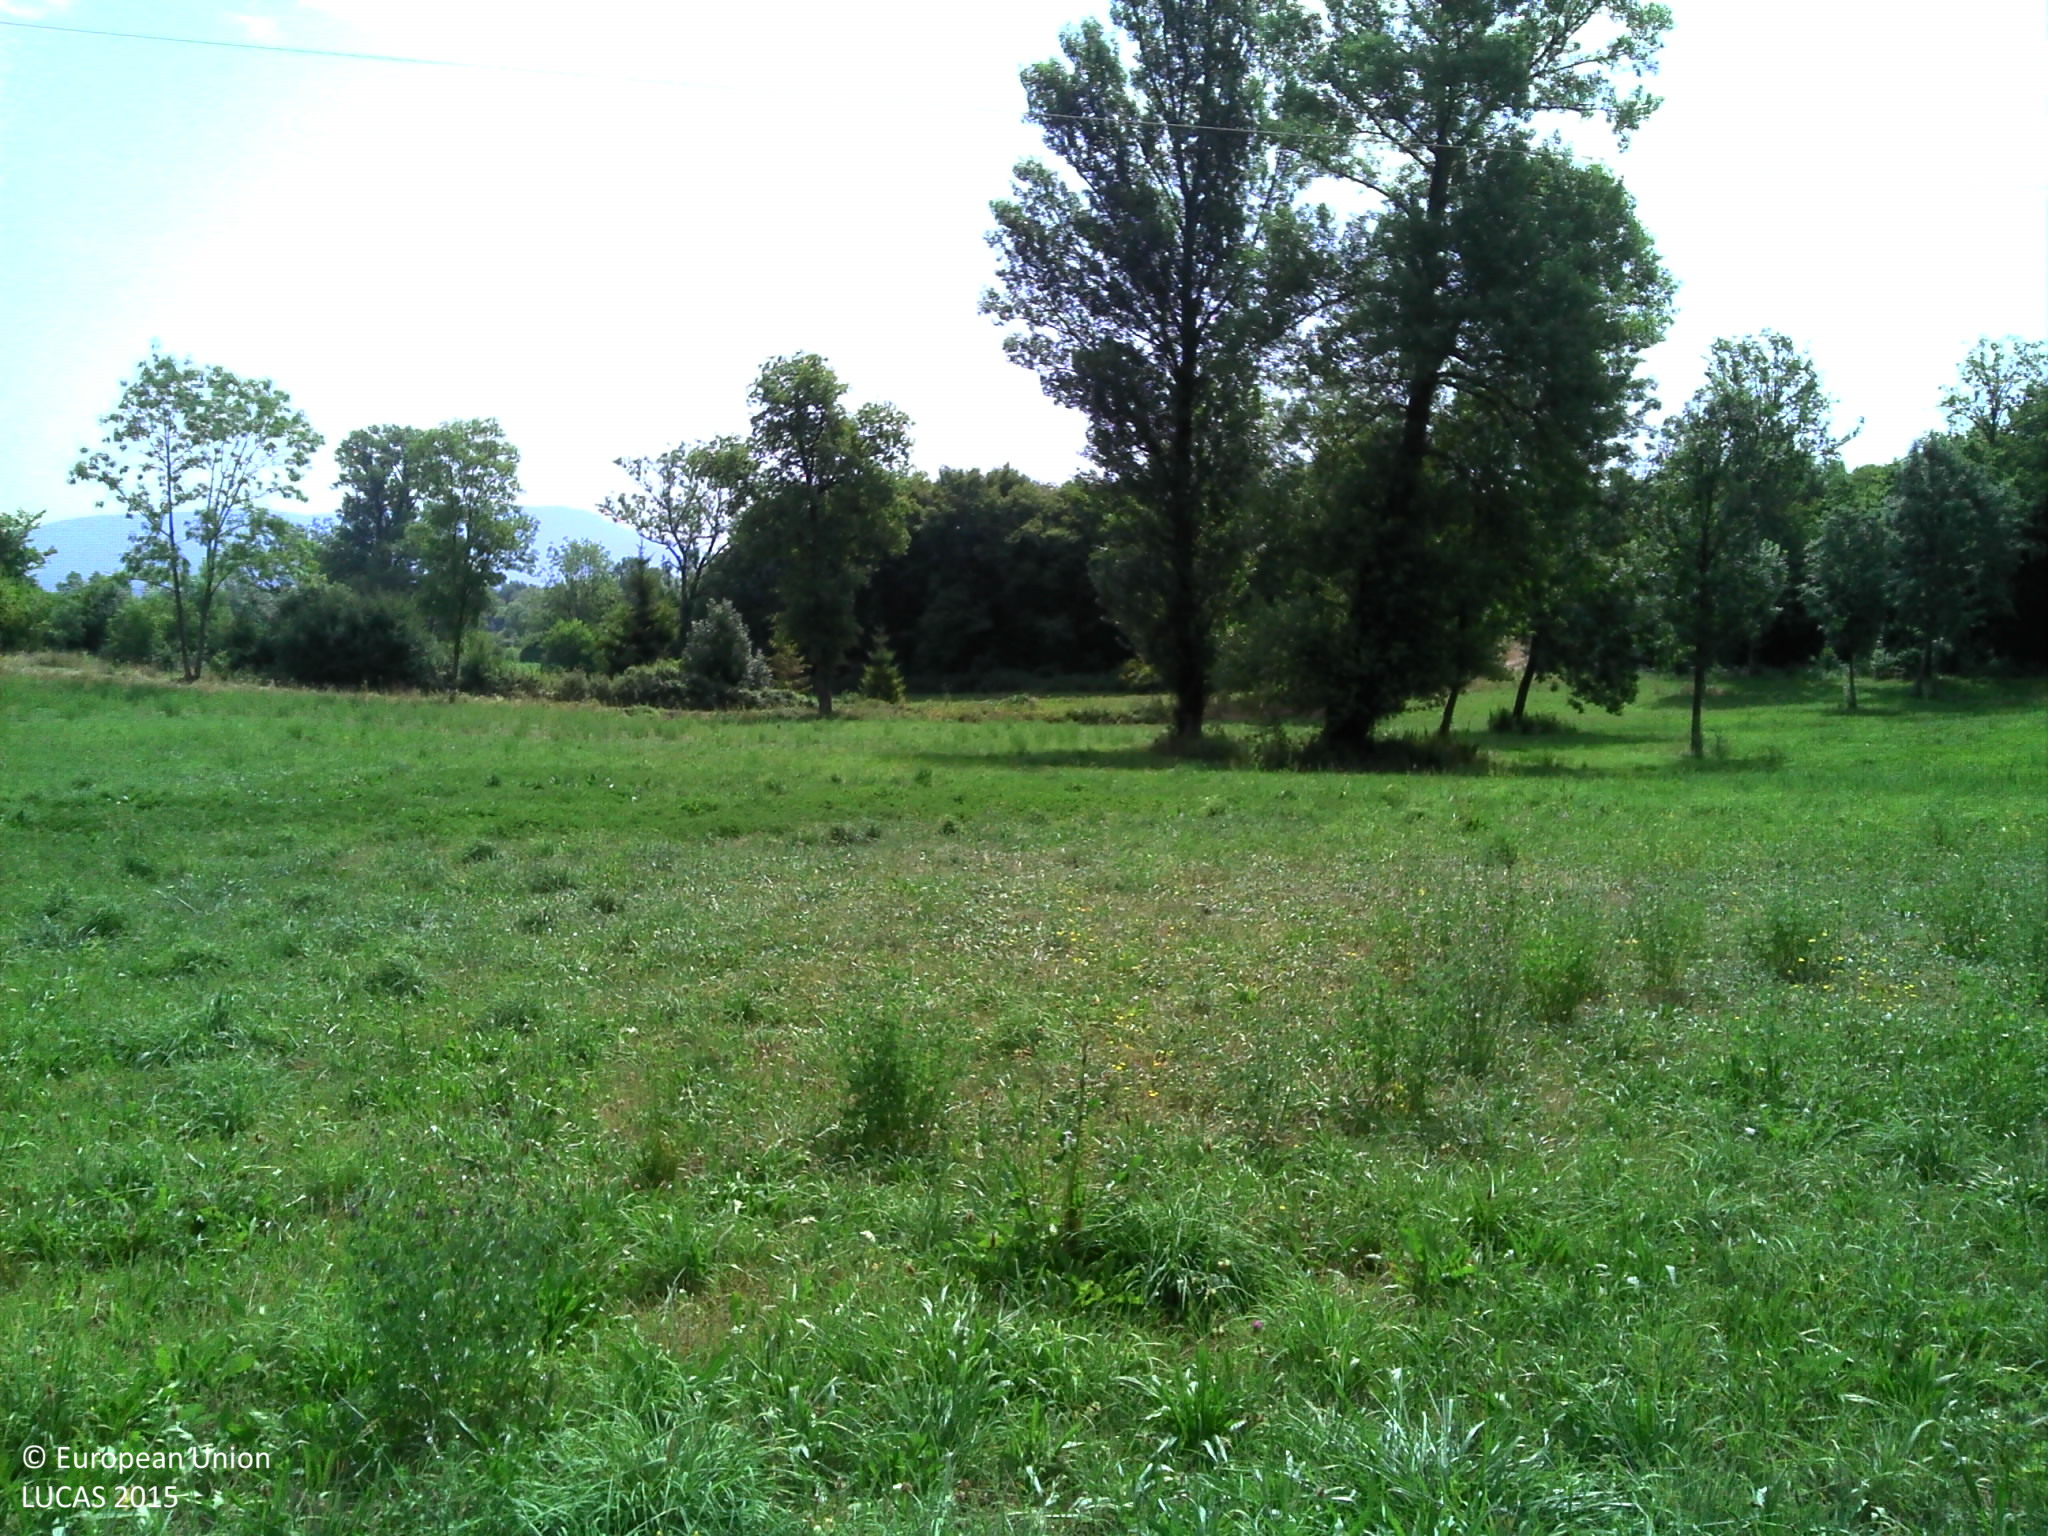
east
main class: Grassland
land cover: Grassland with sparse tree/shrub cover
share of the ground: > 75 %
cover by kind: herbaceous plants 95 %, broadleaved forest trees 5 %
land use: Agriculture (excluding fallow land and kitchen gardens)
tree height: > 5 m
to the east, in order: Grassland with sparse tree/shrub cover; Electric lines; Grassland without tree/shrub cover; Single bushes/trees; Tracks; Fences; Grassland without tree/shrub cover; Other bare soil; Grassland without tree/shrub cover; Rivers and streams; Broadleaved woodland; Maize
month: July
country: FR
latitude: 45.7298
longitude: 5.4167
